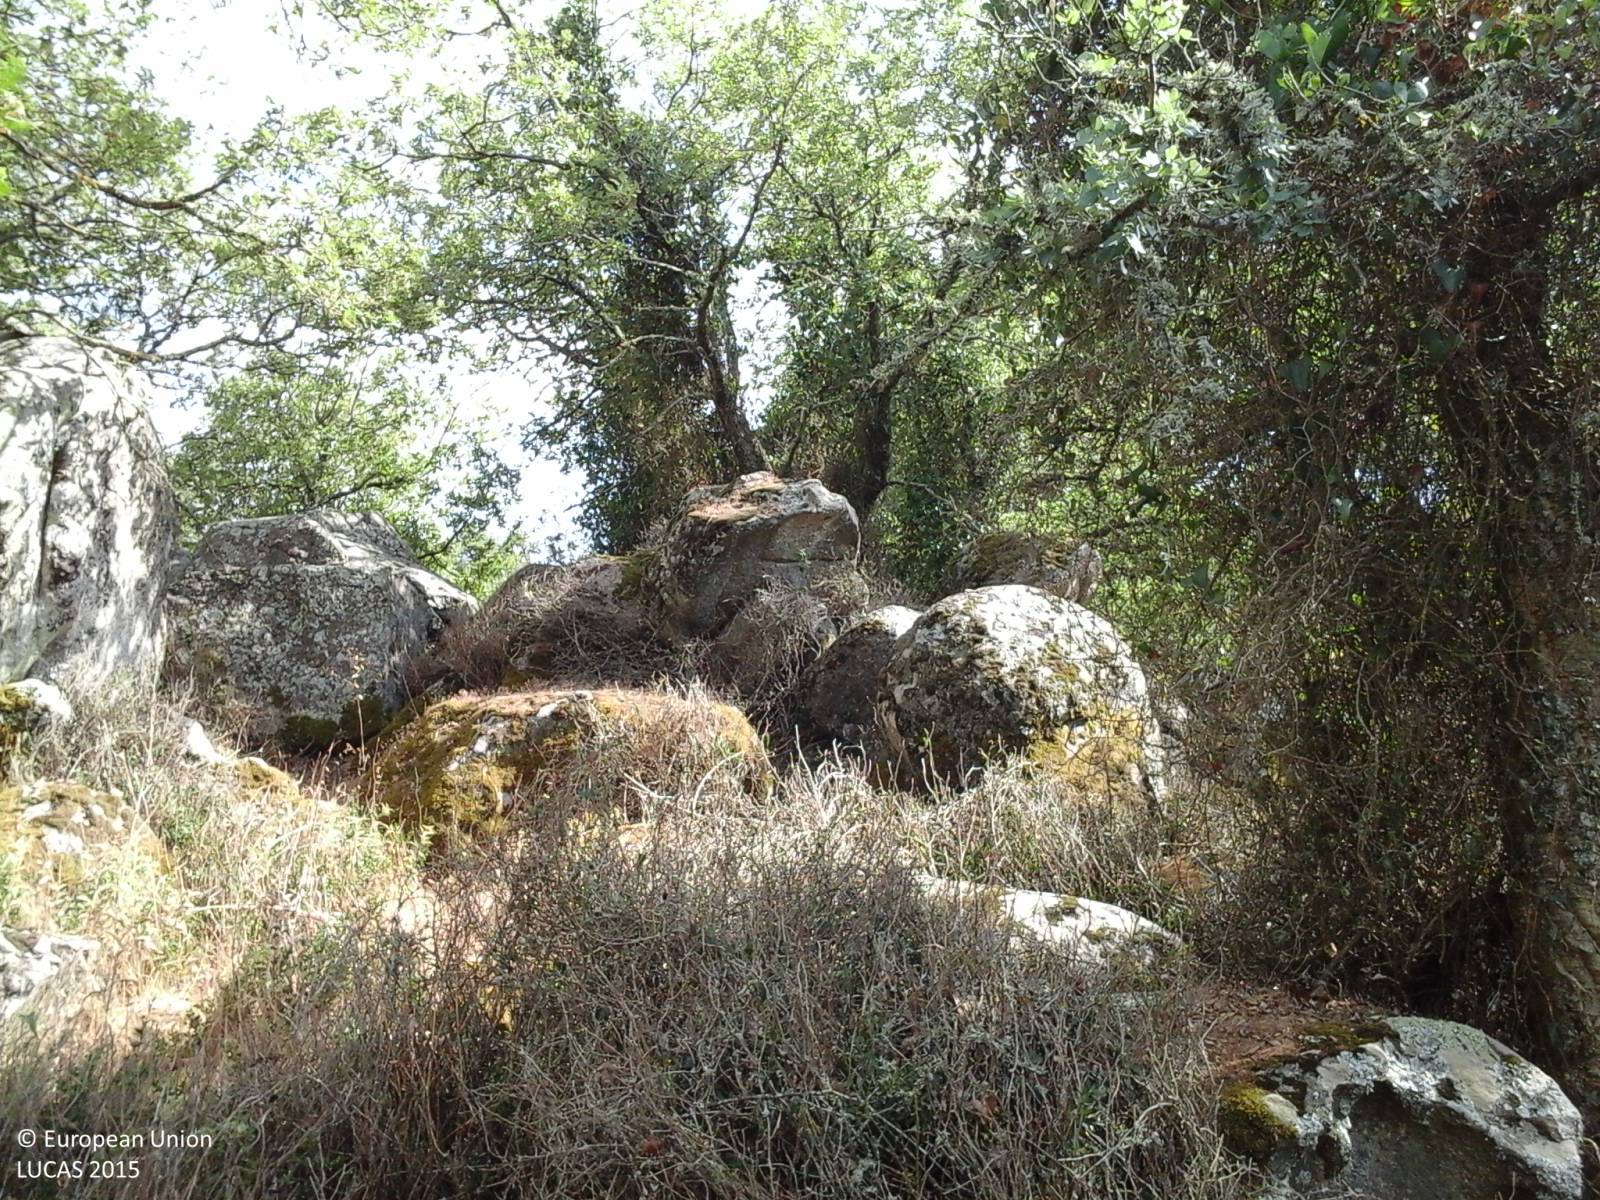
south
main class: Woodland
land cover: Broadleaved woodland
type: broadleaved evergreen forest
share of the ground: > 75 %
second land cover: Grassland without tree/shrub cover
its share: > 75 %
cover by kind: herbaceous plants 55 %, shrubs 35 %, broadleaved forest trees 10 %
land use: Forestry
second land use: Agriculture (excluding fallow land and kitchen gardens)
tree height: > 5 m
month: August
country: IT
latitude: 40.5353
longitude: 9.1660
